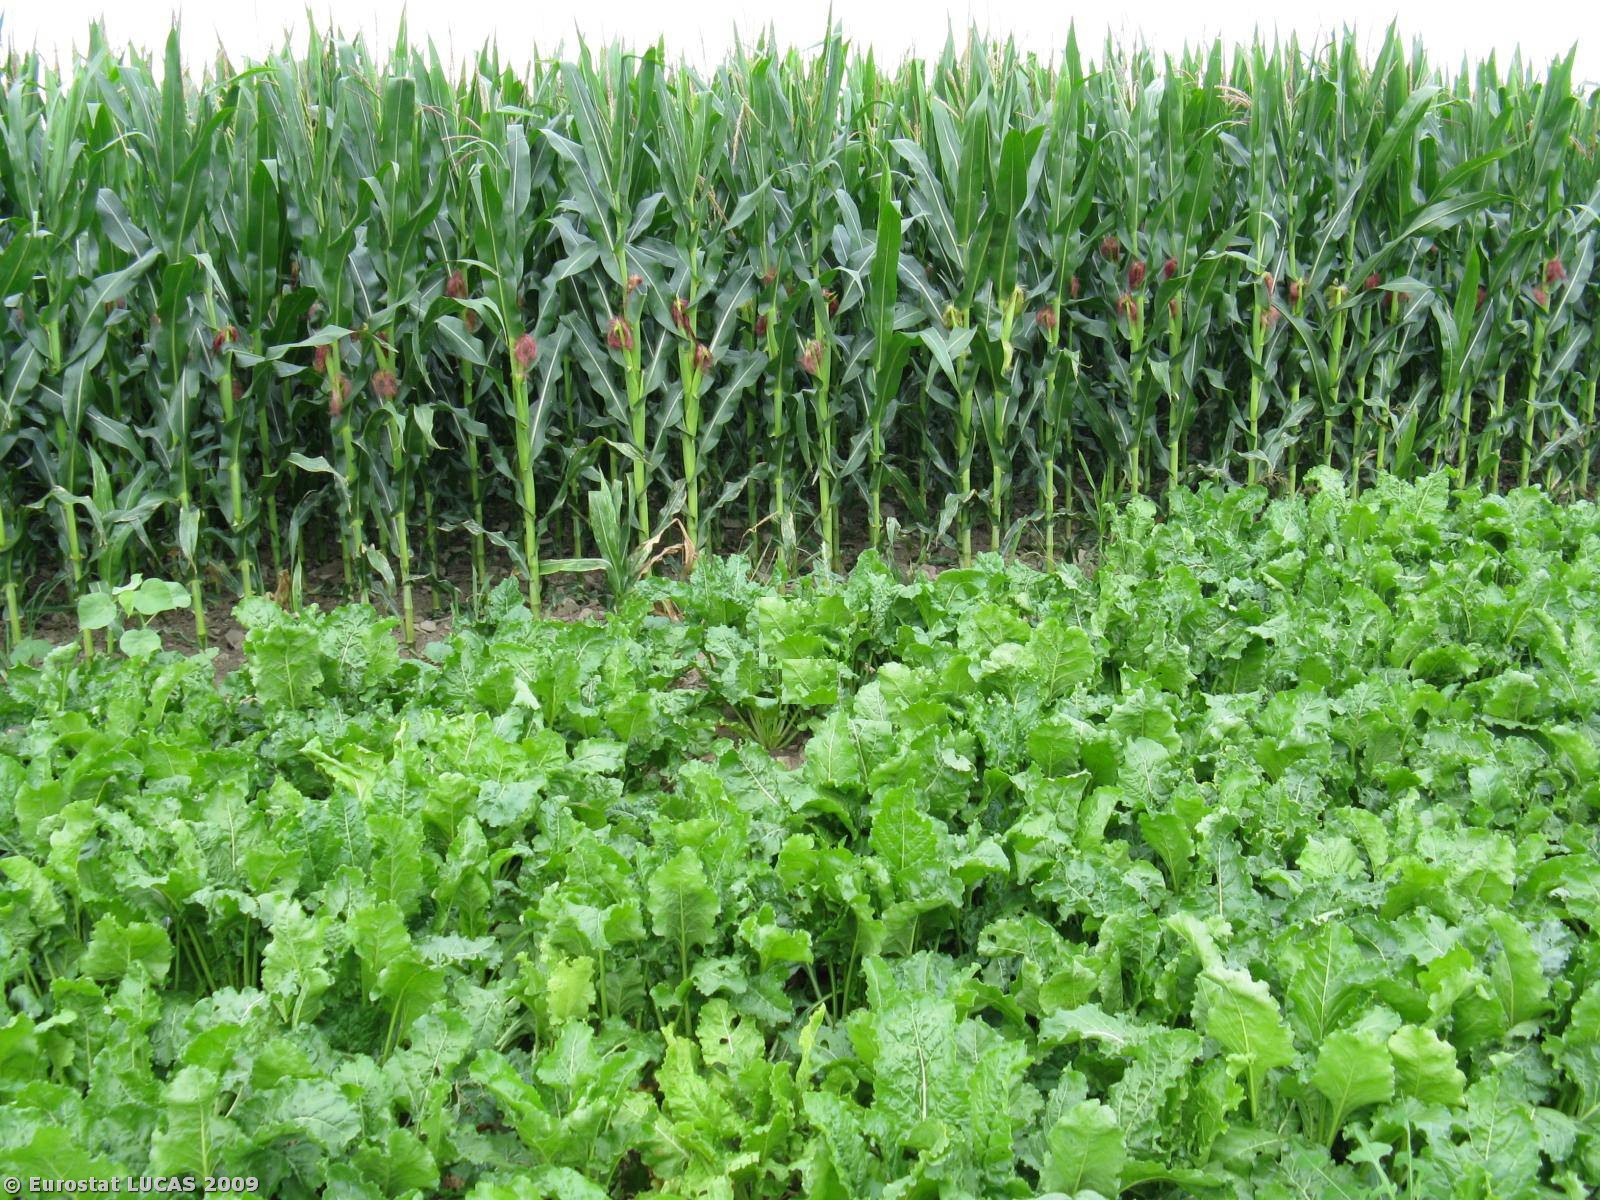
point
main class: Cropland
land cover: Maize
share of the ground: > 75 %
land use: Agriculture (excluding fallow land and kitchen gardens)
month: June
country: IT
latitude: 44.8785
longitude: 11.6551
